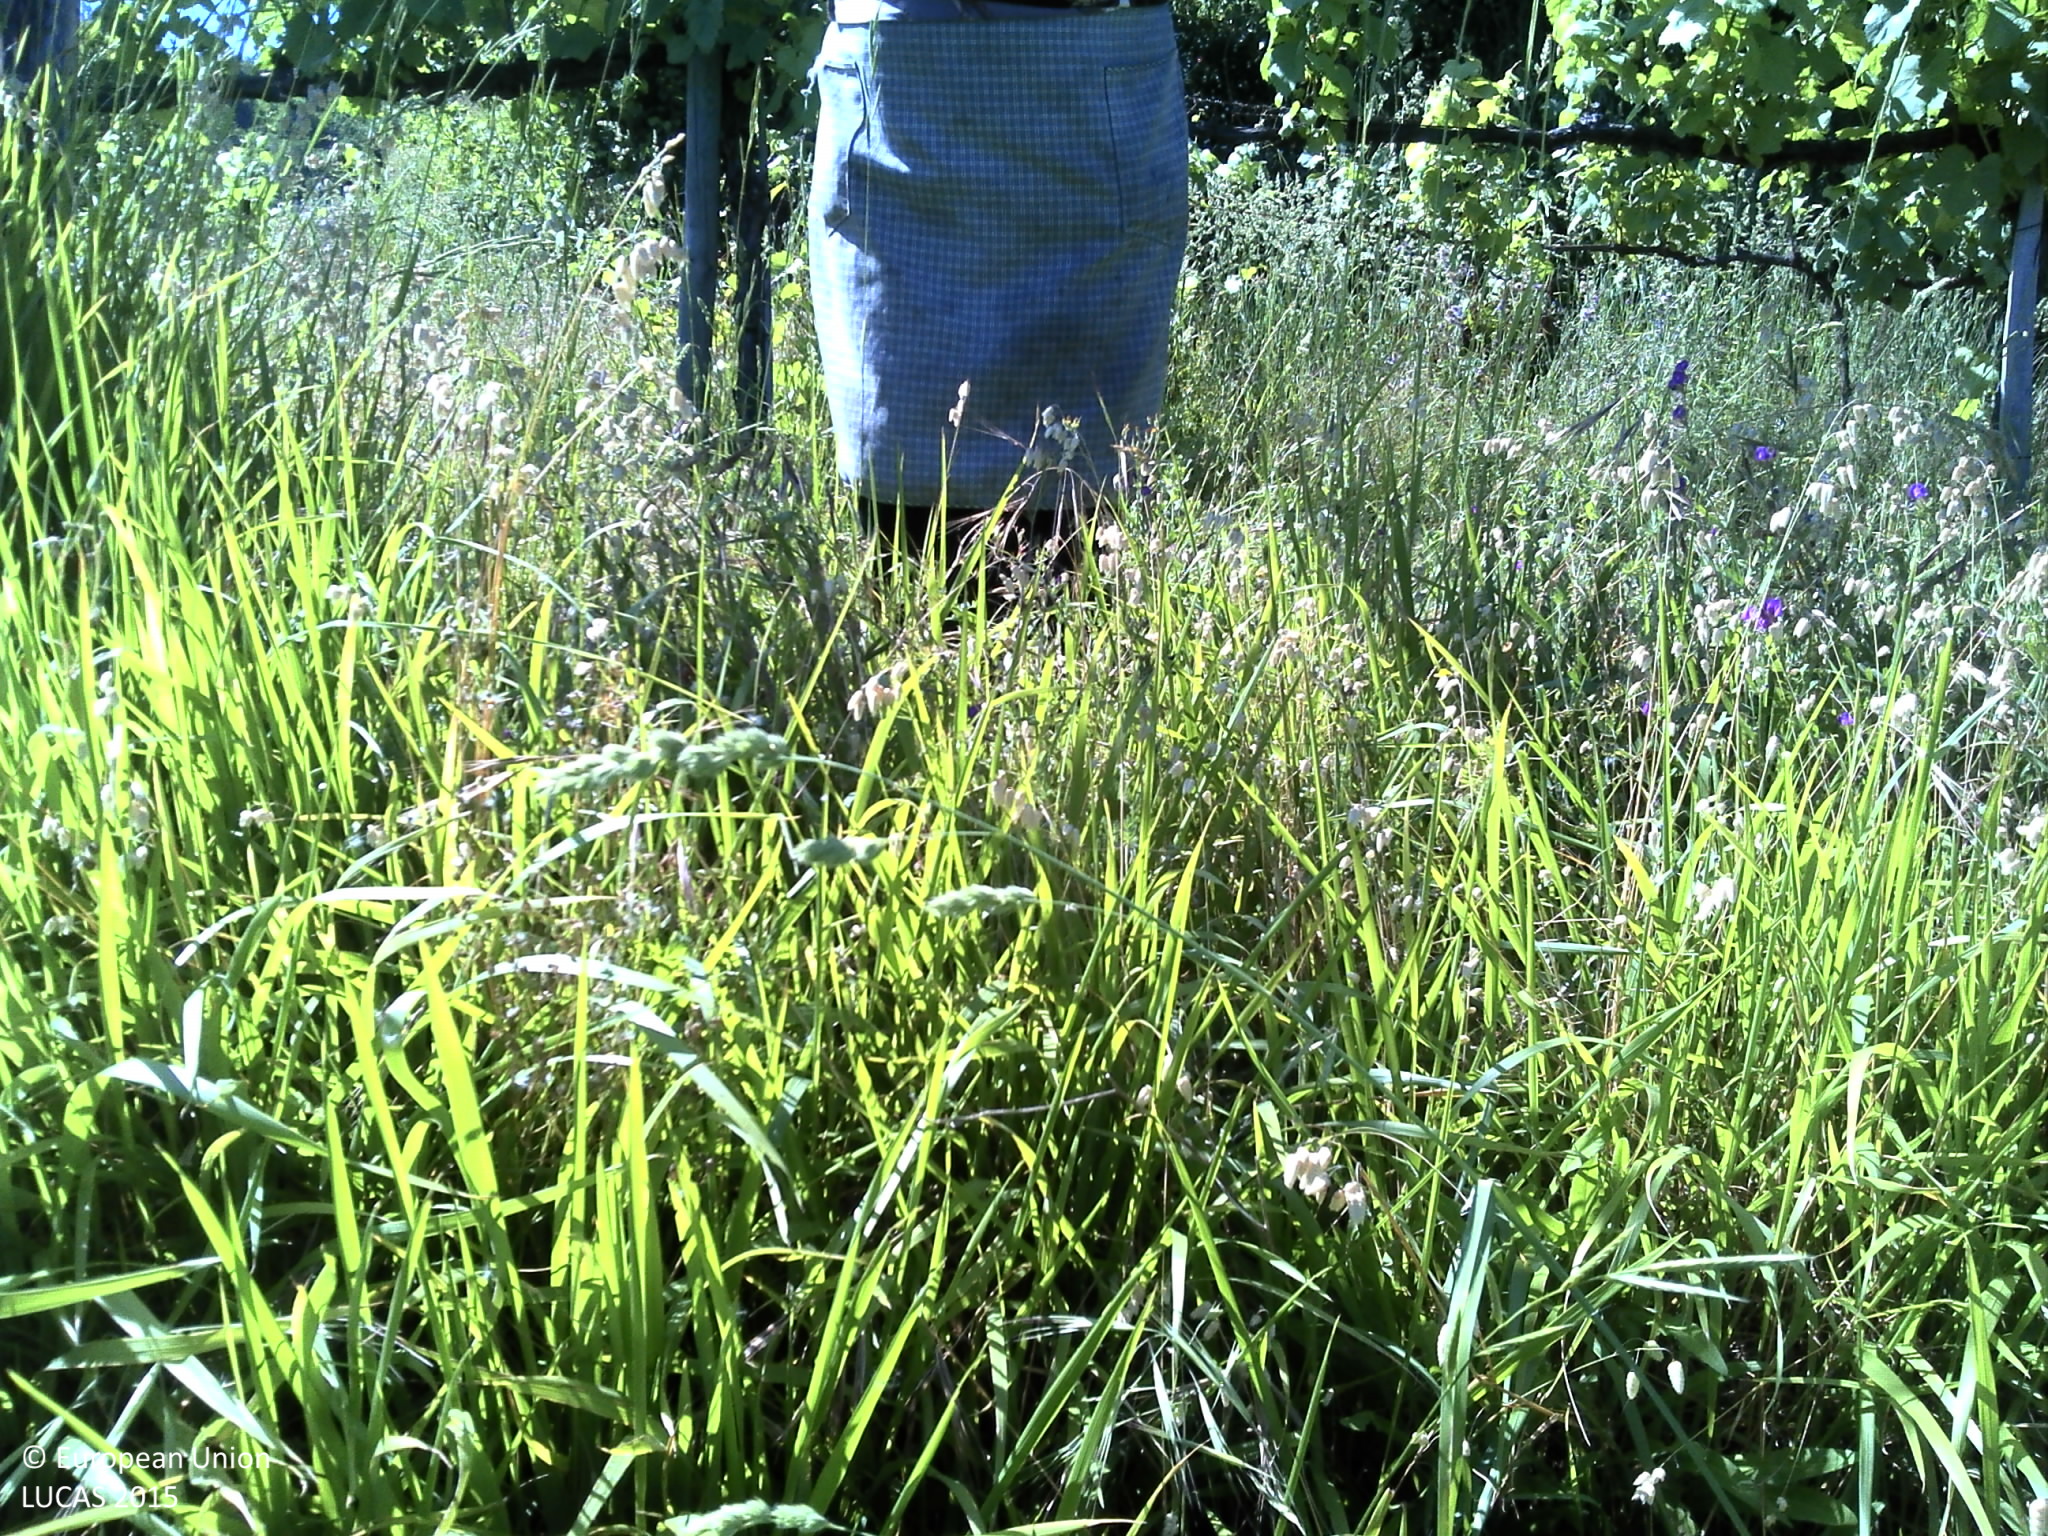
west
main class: Cropland
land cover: Vineyards
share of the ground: 10 - 25 %
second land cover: Grassland without tree/shrub cover
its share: 50 - 75 %
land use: Agriculture (excluding fallow land and kitchen gardens)
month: June
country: PT
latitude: 41.8419
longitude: -8.3783
